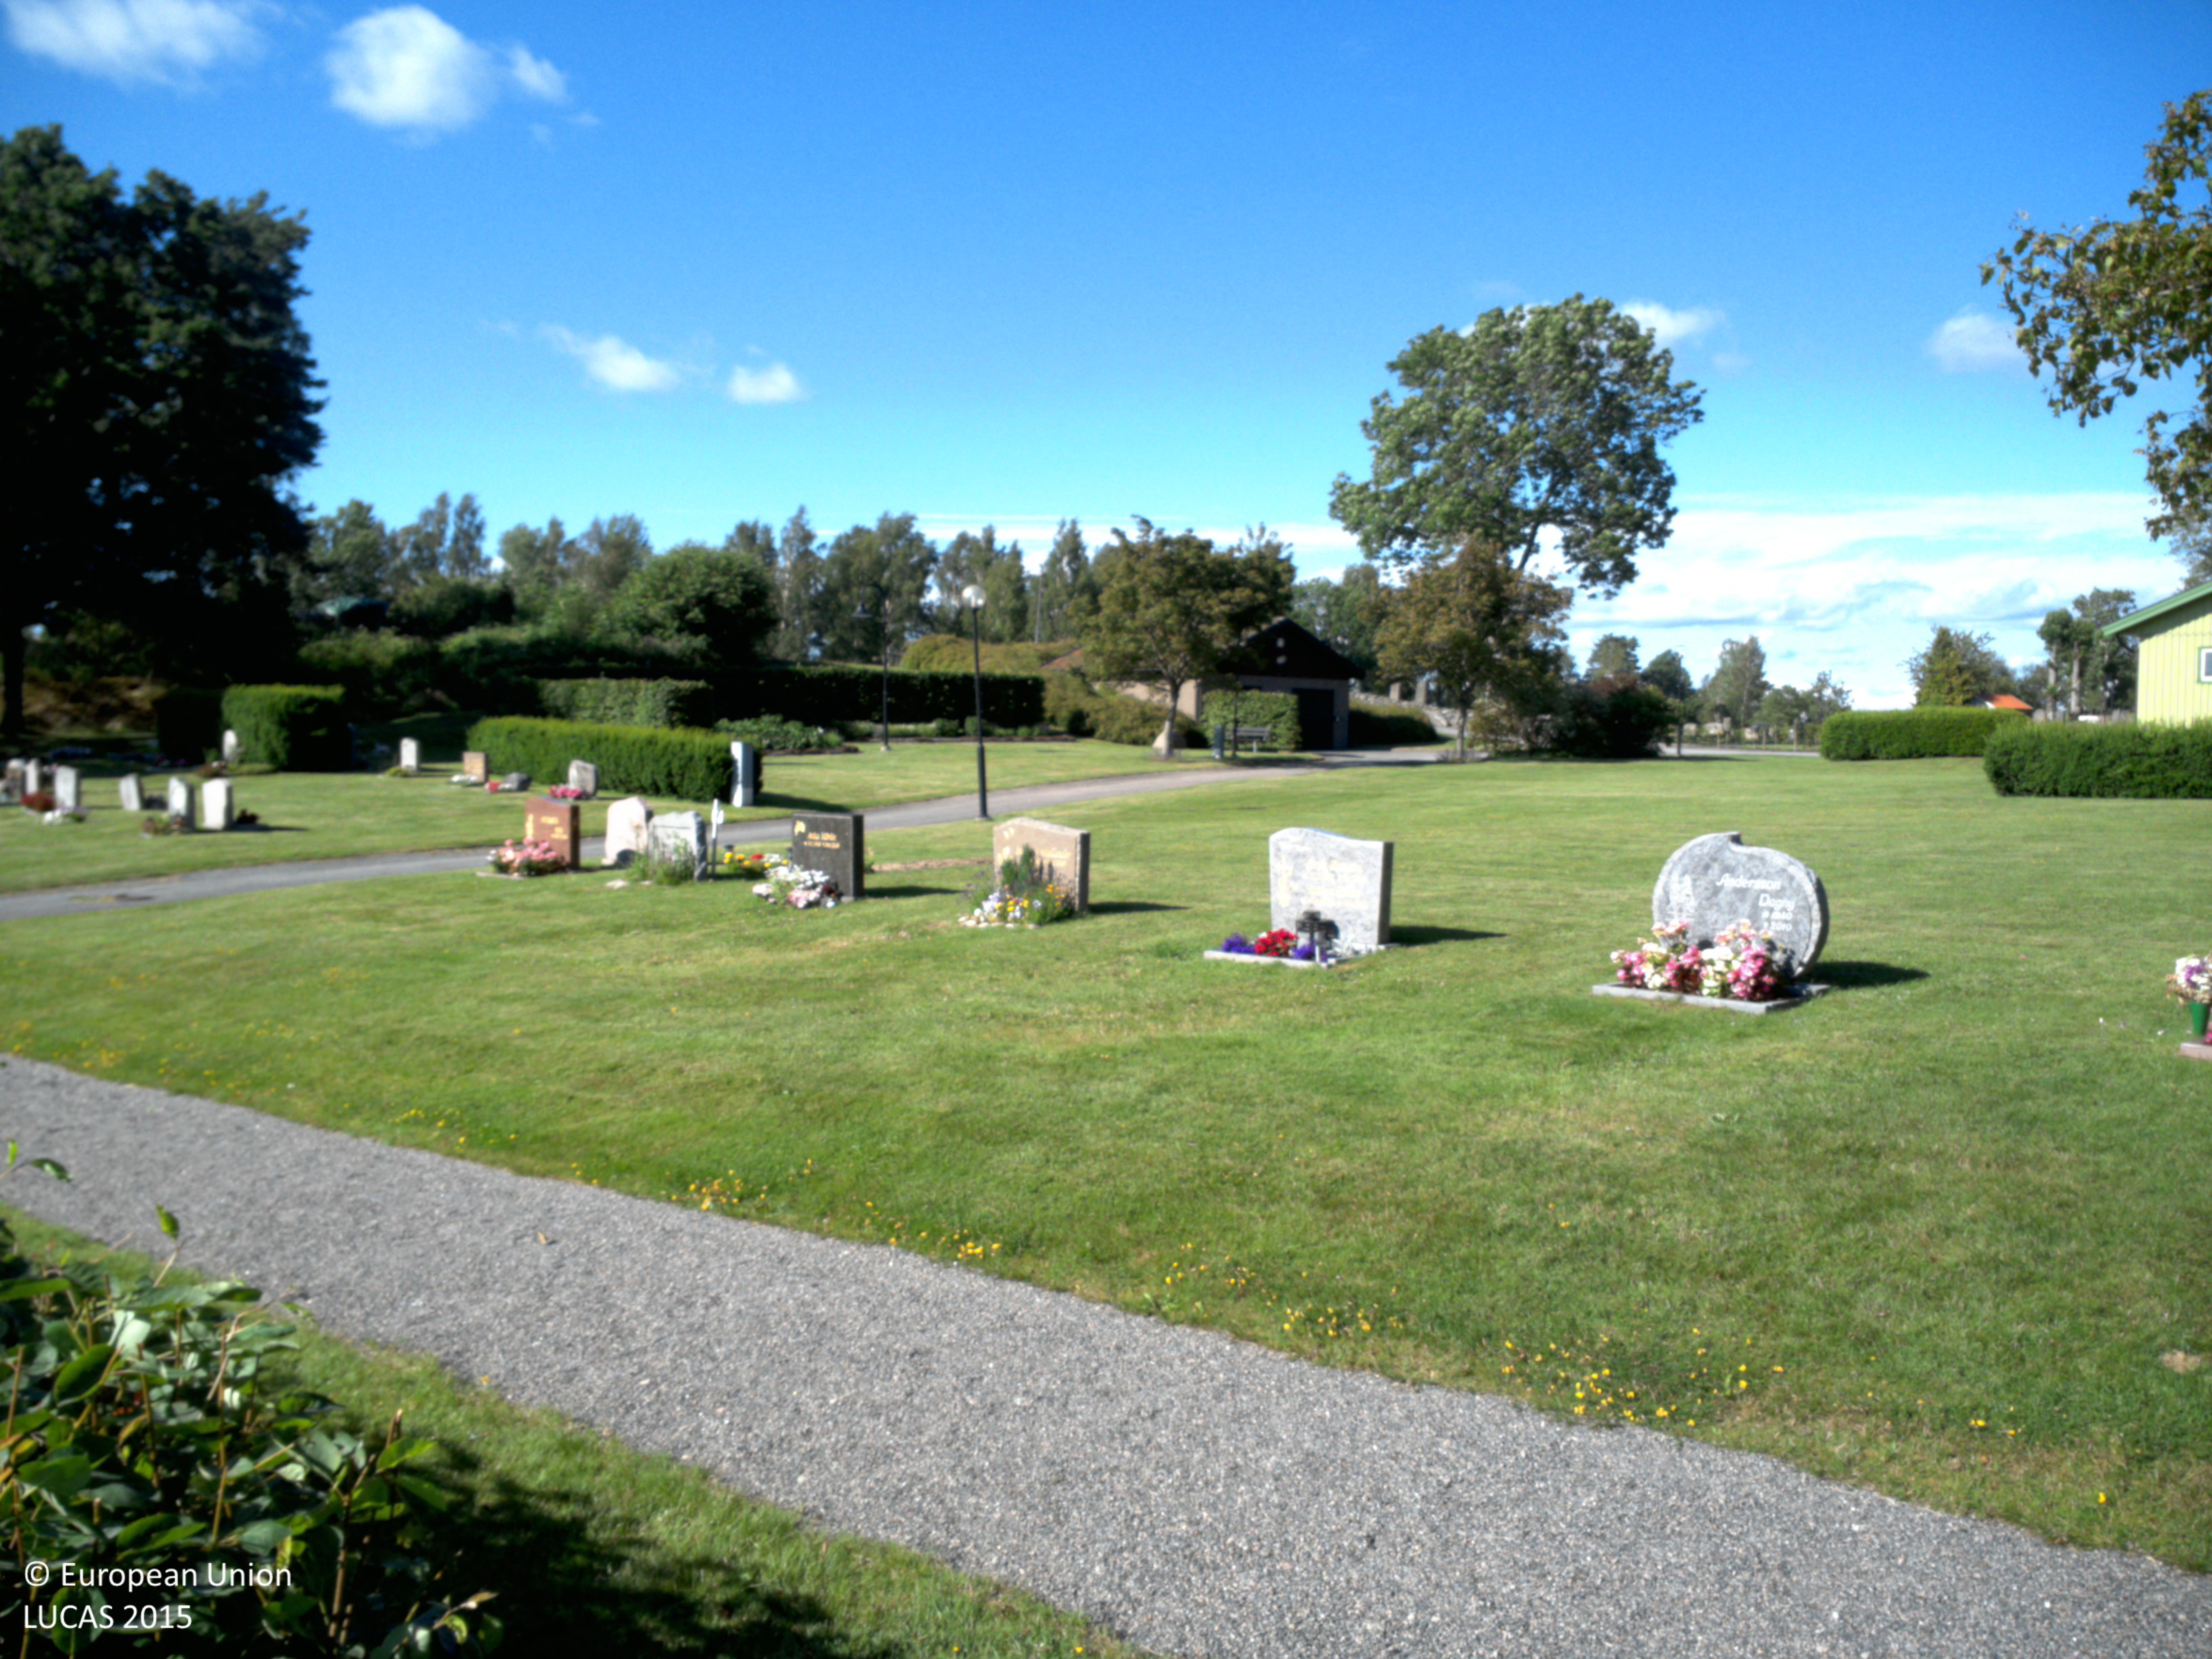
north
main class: Grassland
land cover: Grassland without tree/shrub cover
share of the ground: > 75 %
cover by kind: herbaceous plants 100 %
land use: Community services
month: July
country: SE
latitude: 57.9854
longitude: 12.2116
